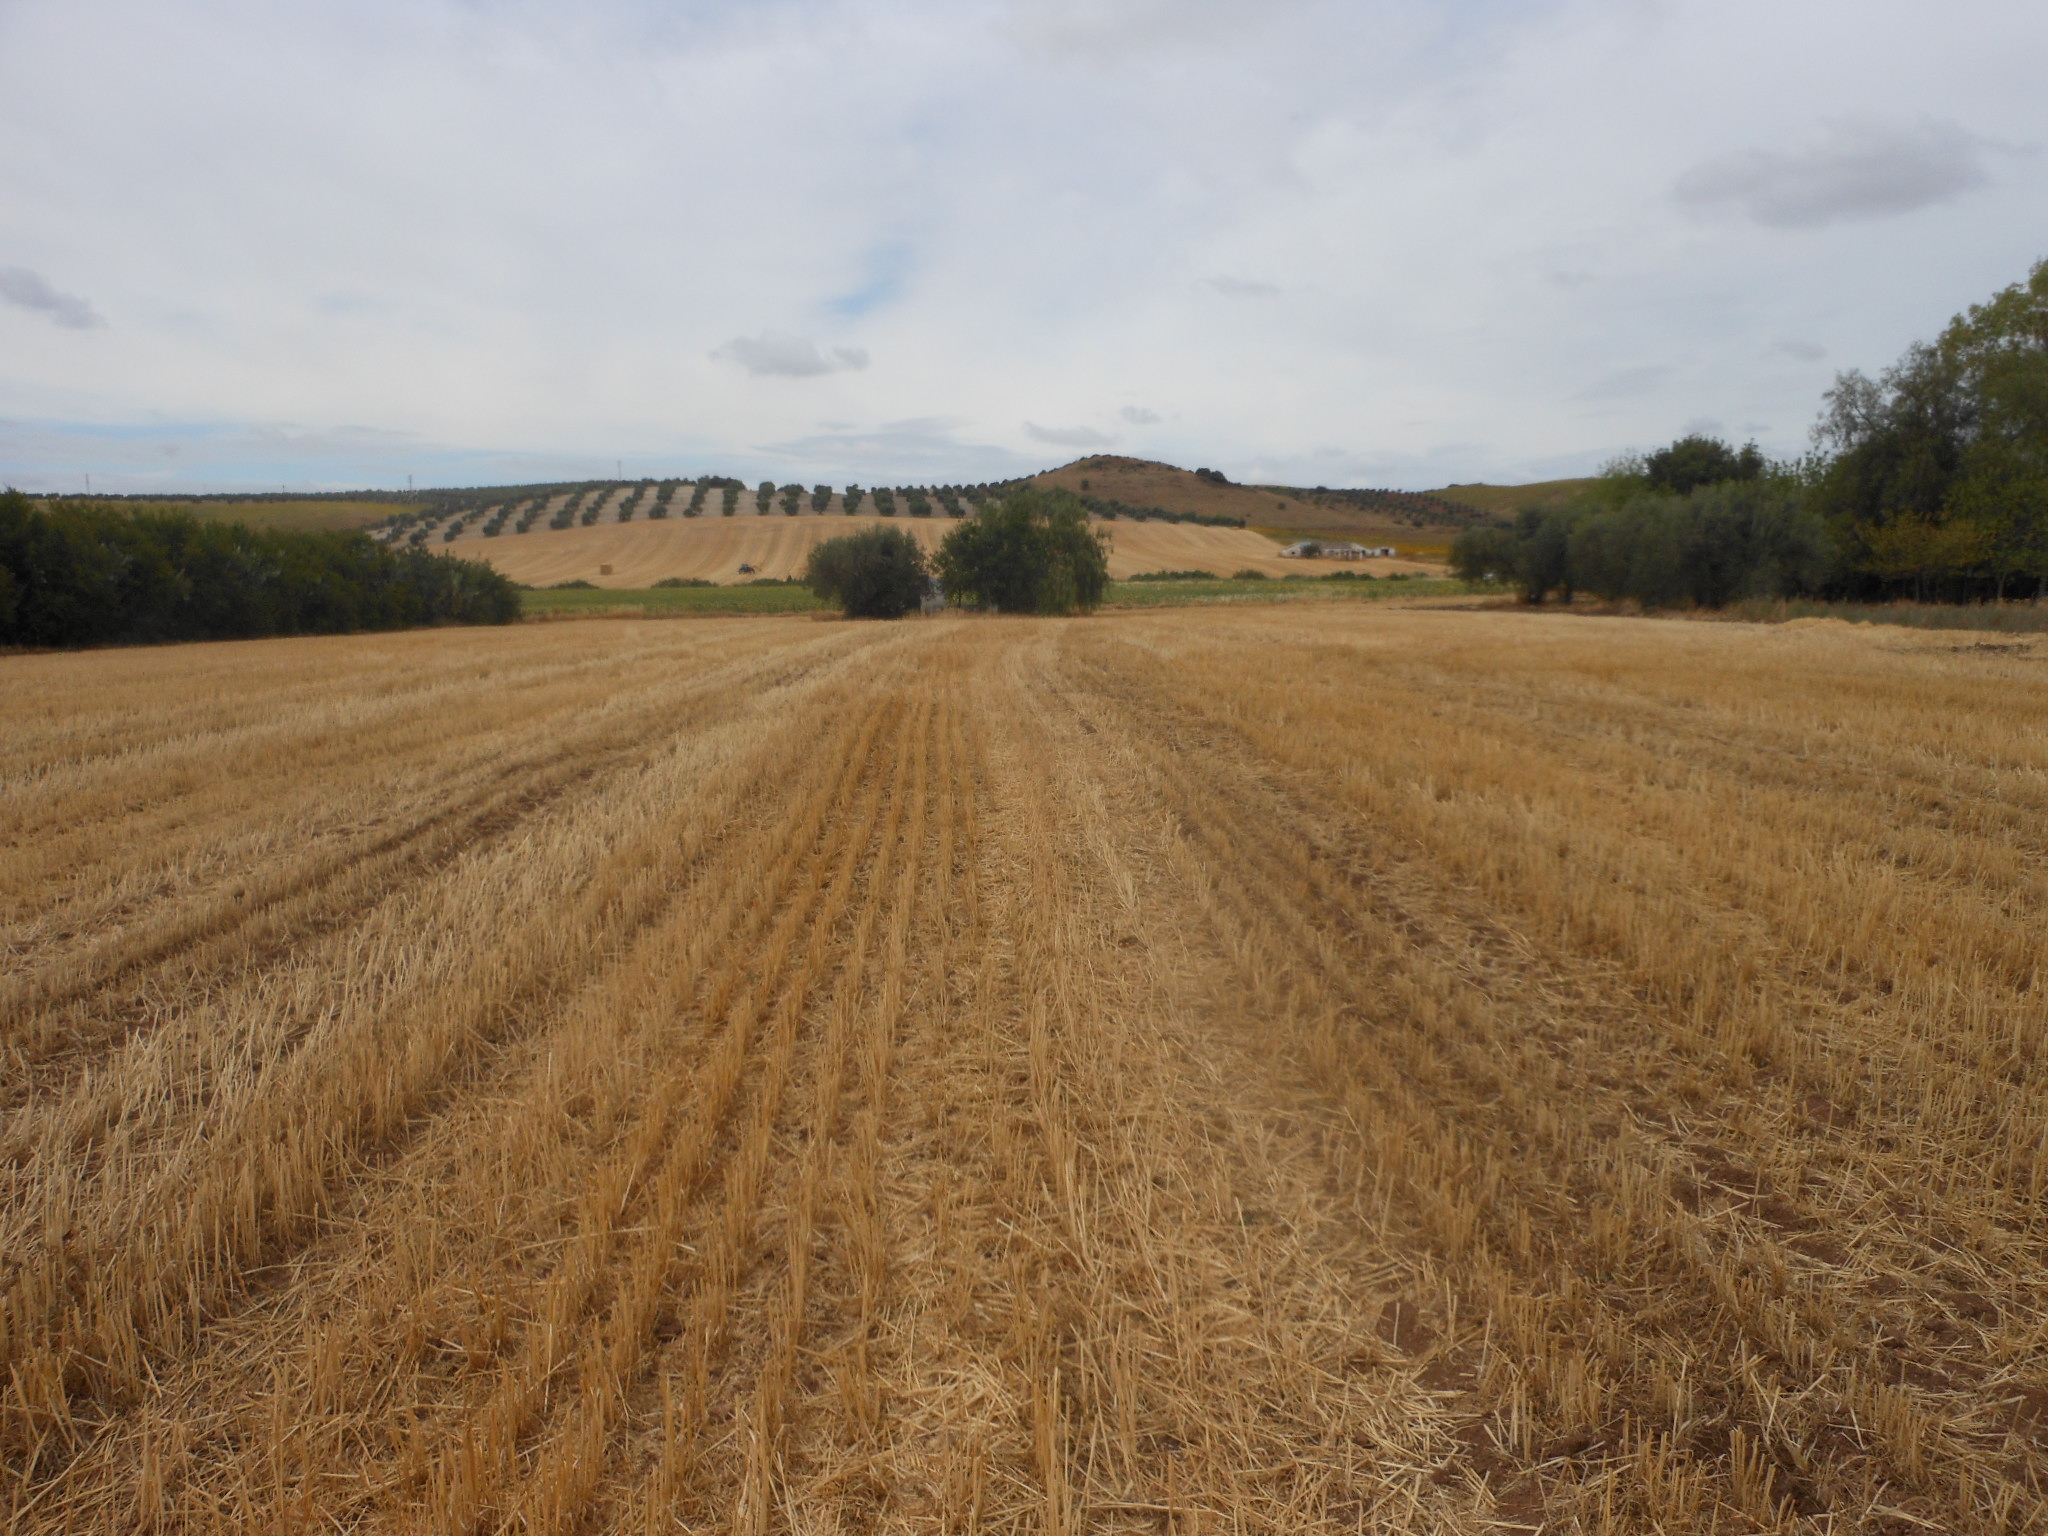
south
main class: Cropland
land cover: Common wheat
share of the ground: < 10 %
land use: Agriculture (excluding fallow land and kitchen gardens)
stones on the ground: < 10 %
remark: Harvested field
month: June
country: ES
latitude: 37.1620
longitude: -5.4269
